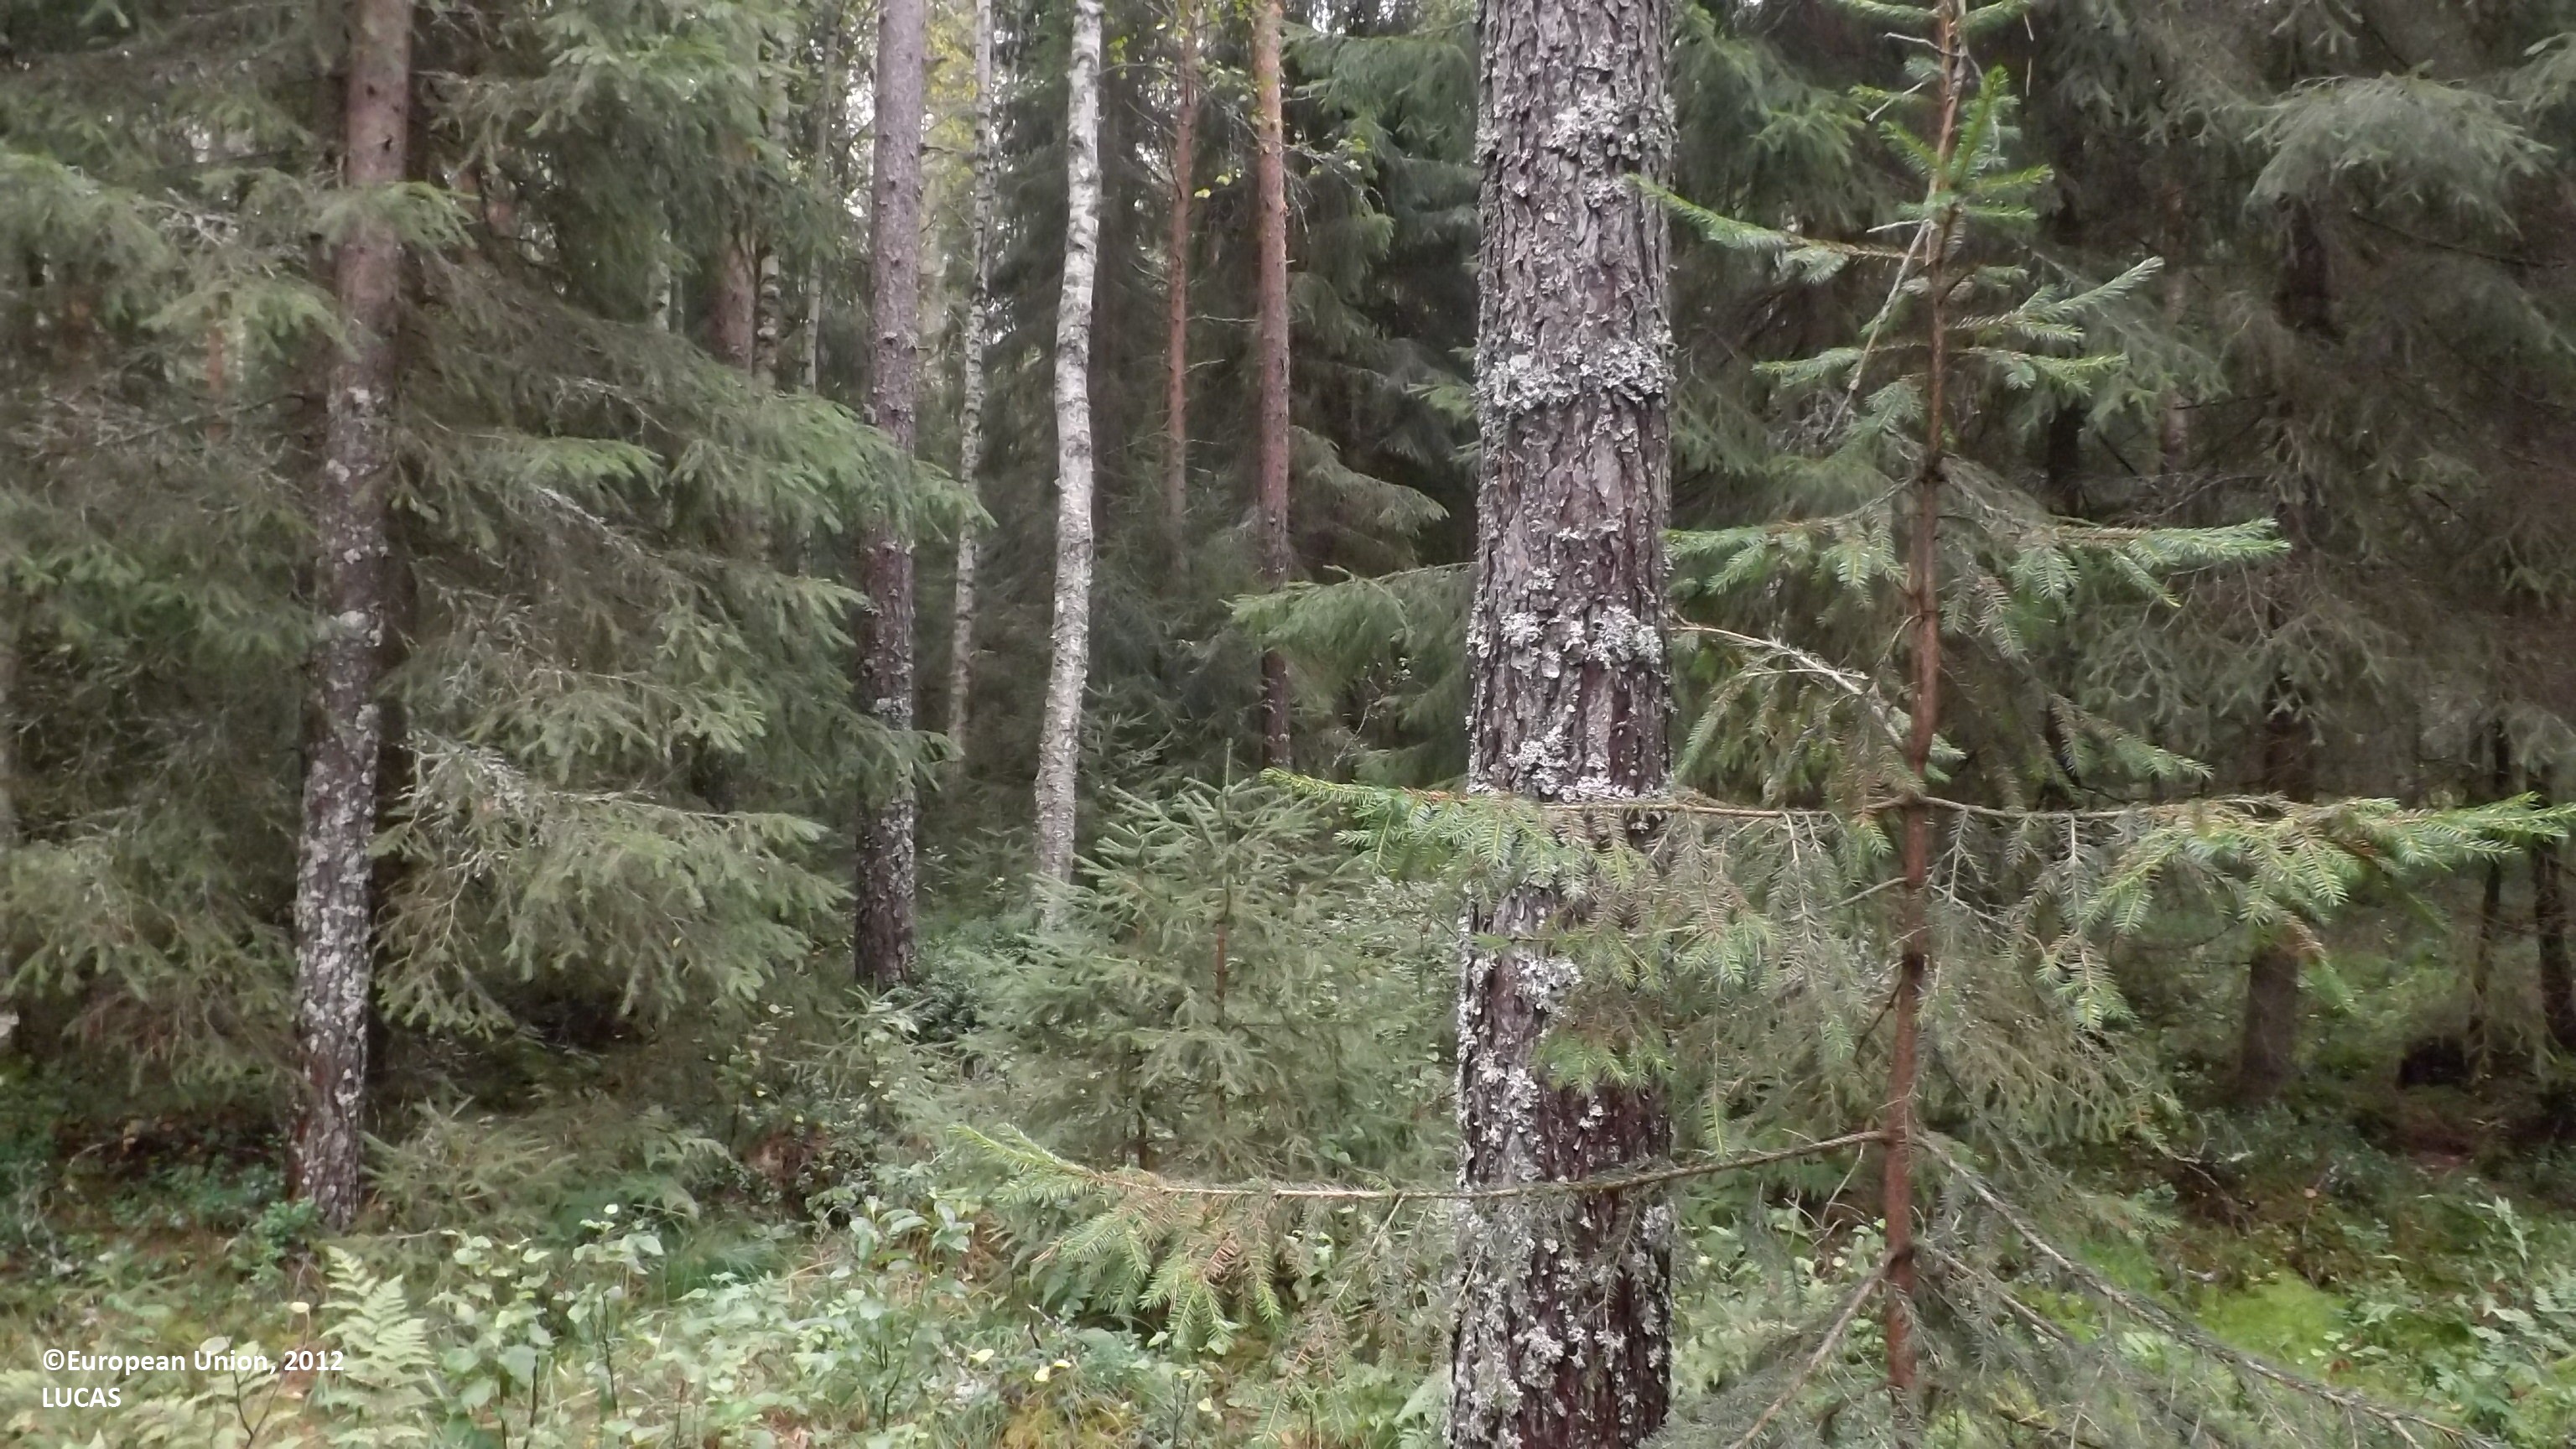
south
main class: Woodland
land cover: Other mixed woodland
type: boreal forest
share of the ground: 50 - 75 %
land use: Forestry
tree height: > 5 m
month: August
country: FI
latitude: 63.7697
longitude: 23.4220
